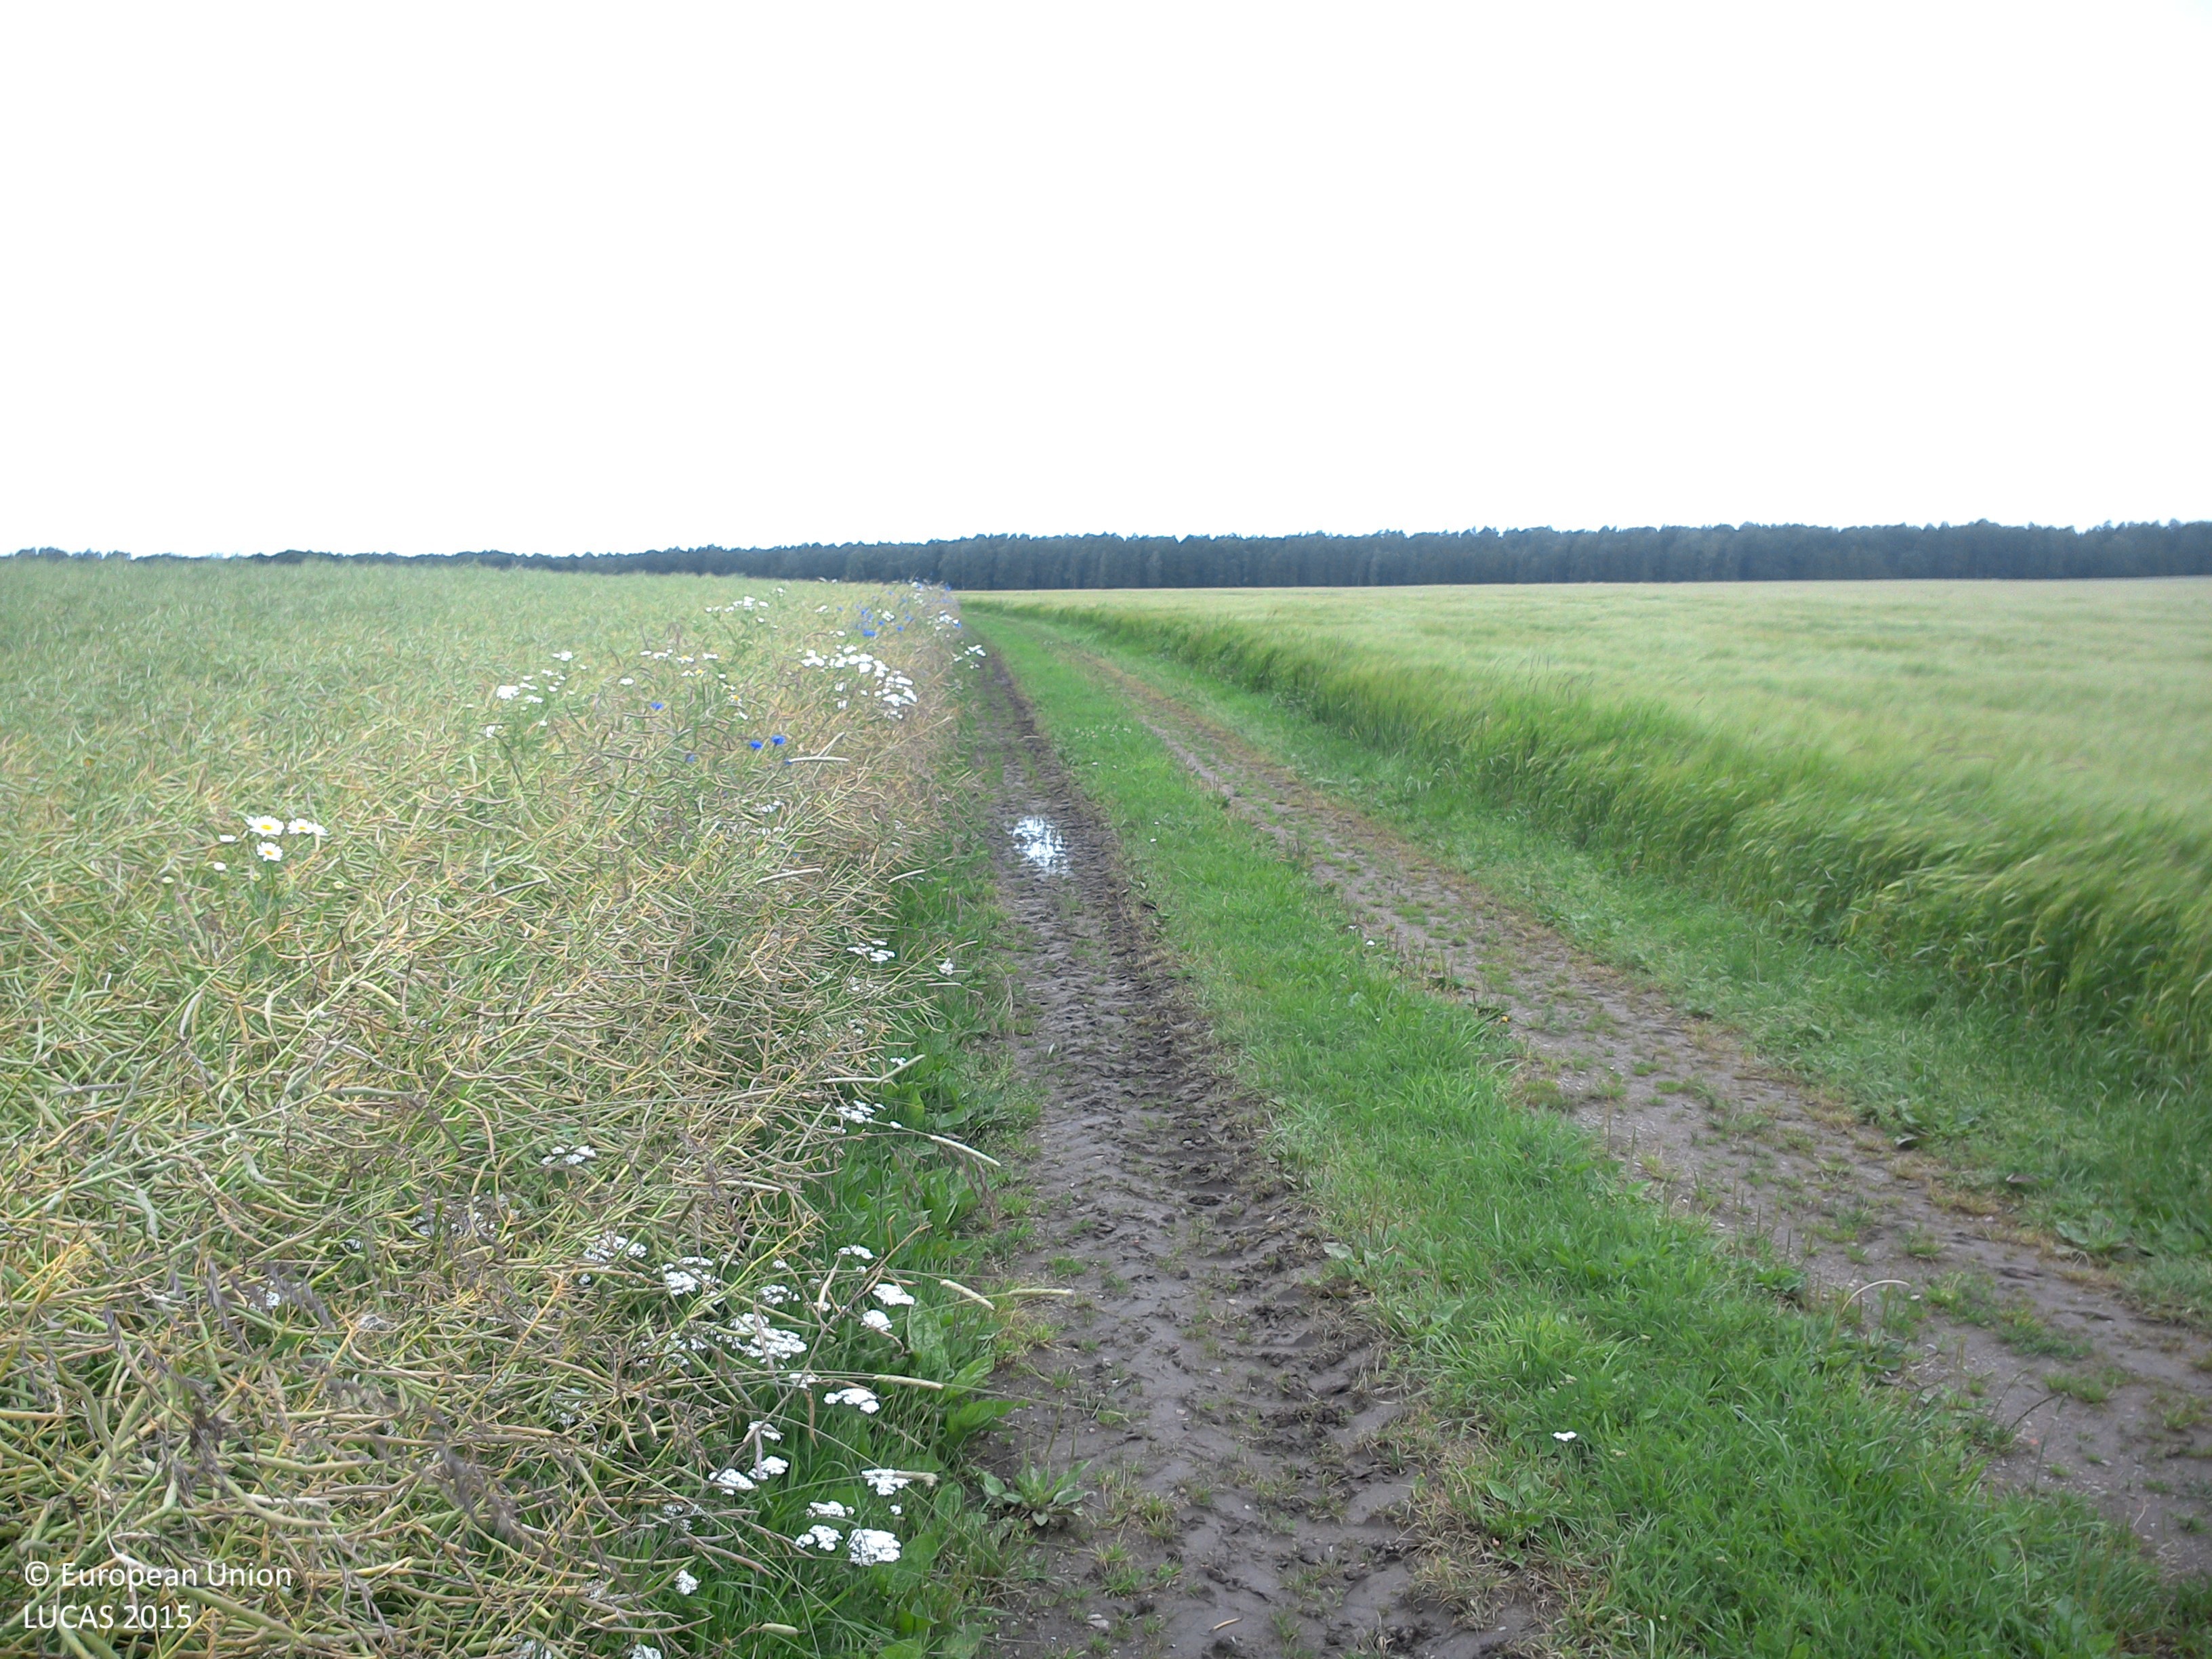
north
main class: Cropland
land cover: Rape and turnip rape
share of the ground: > 75 %
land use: Agriculture (excluding fallow land and kitchen gardens)
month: July
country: SE
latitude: 58.3299
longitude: 14.8609
